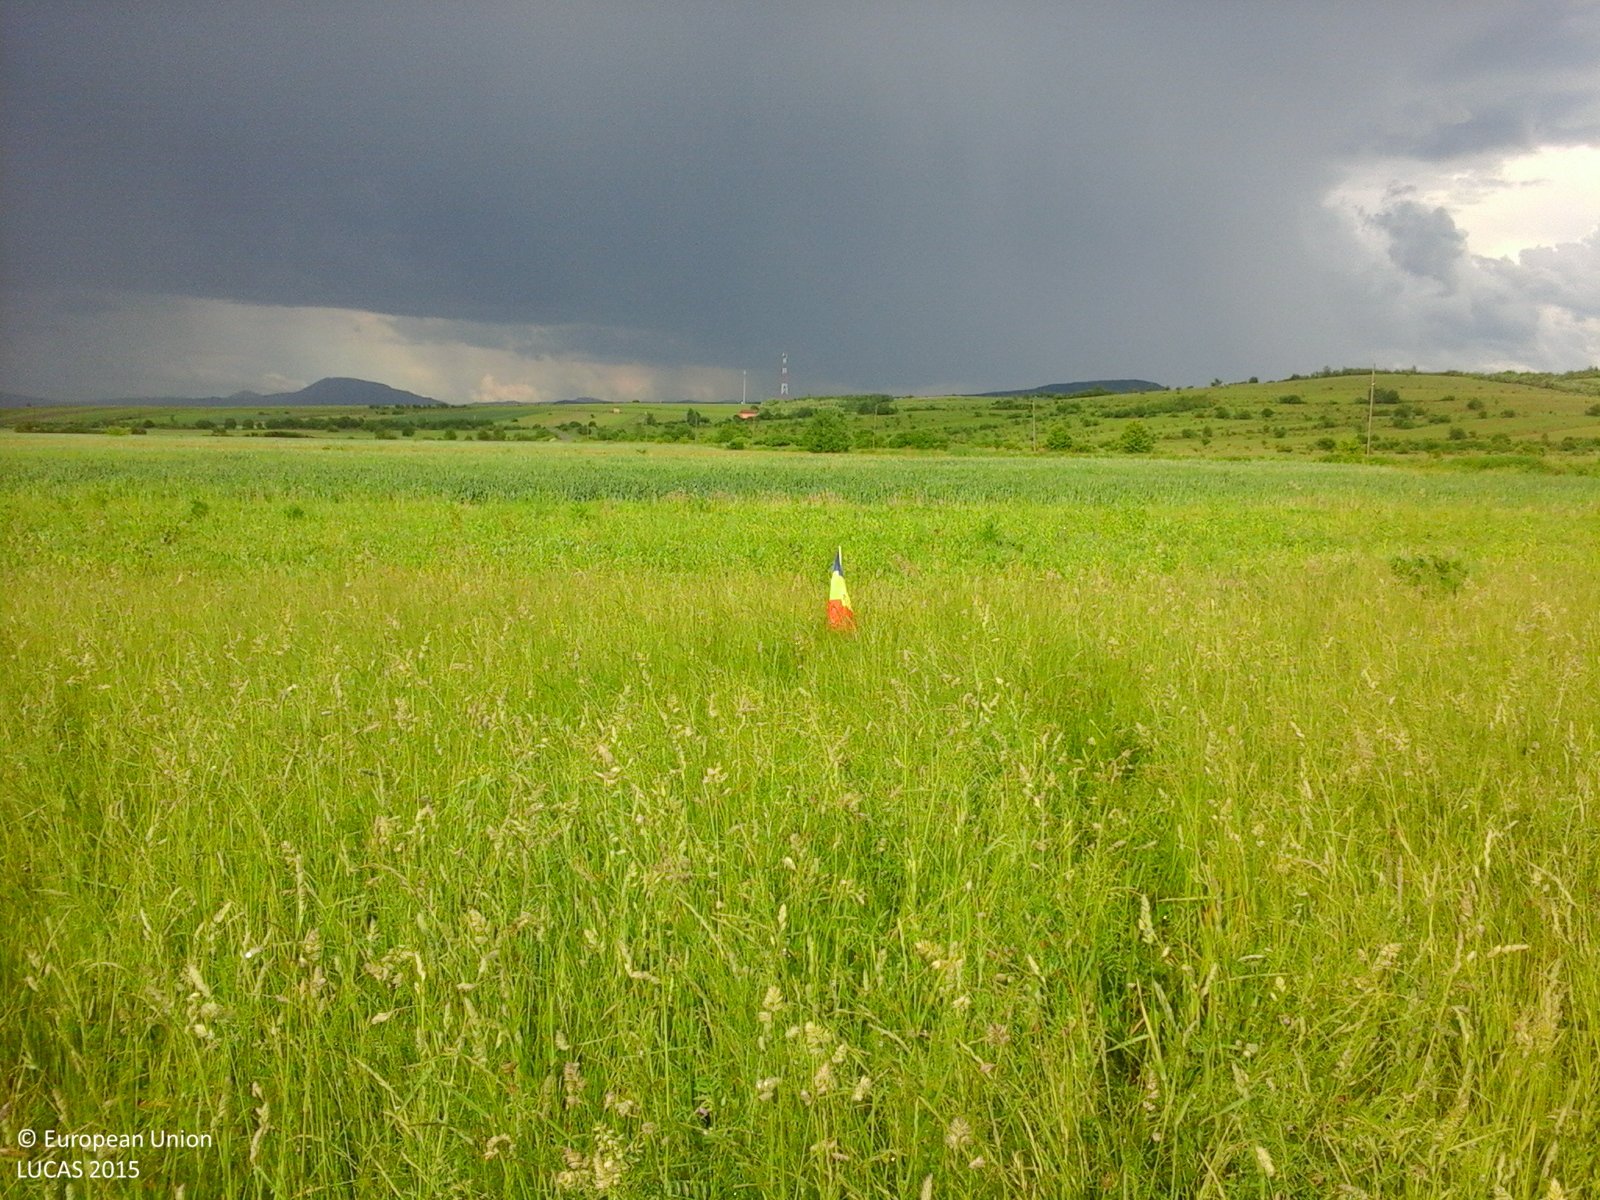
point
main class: Grassland
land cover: Spontaneously vegetated surfaces
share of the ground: > 75 %
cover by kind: herbaceous plants 100 %
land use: Semi-natural and natural areas not in use
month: May
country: RO
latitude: 45.7726
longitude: 25.1805
